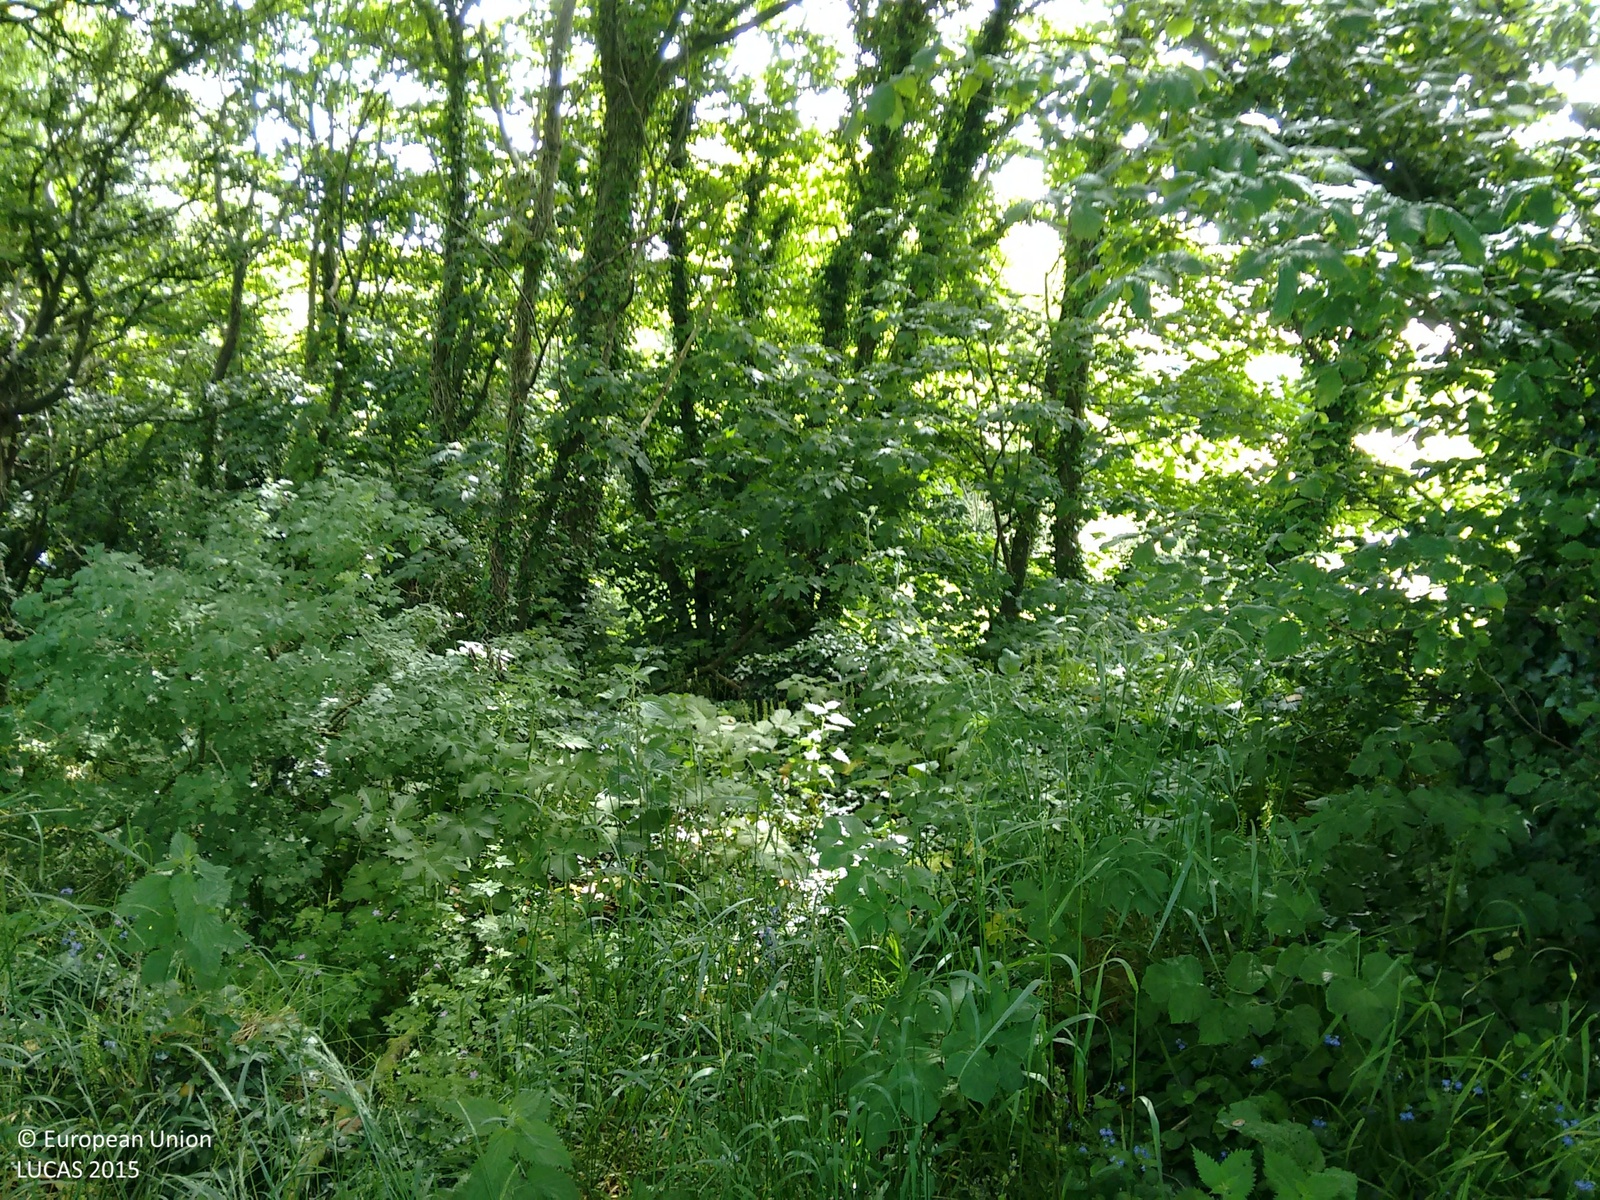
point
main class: Woodland
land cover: Broadleaved woodland
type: acidophilous oak and oak-birch forest
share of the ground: > 75 %
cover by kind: broadleaved forest trees 95 %, shrubs 5 %
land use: Semi-natural and natural areas not in use
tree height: > 5 m
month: June
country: IE
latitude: 52.1655
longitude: -7.3924
